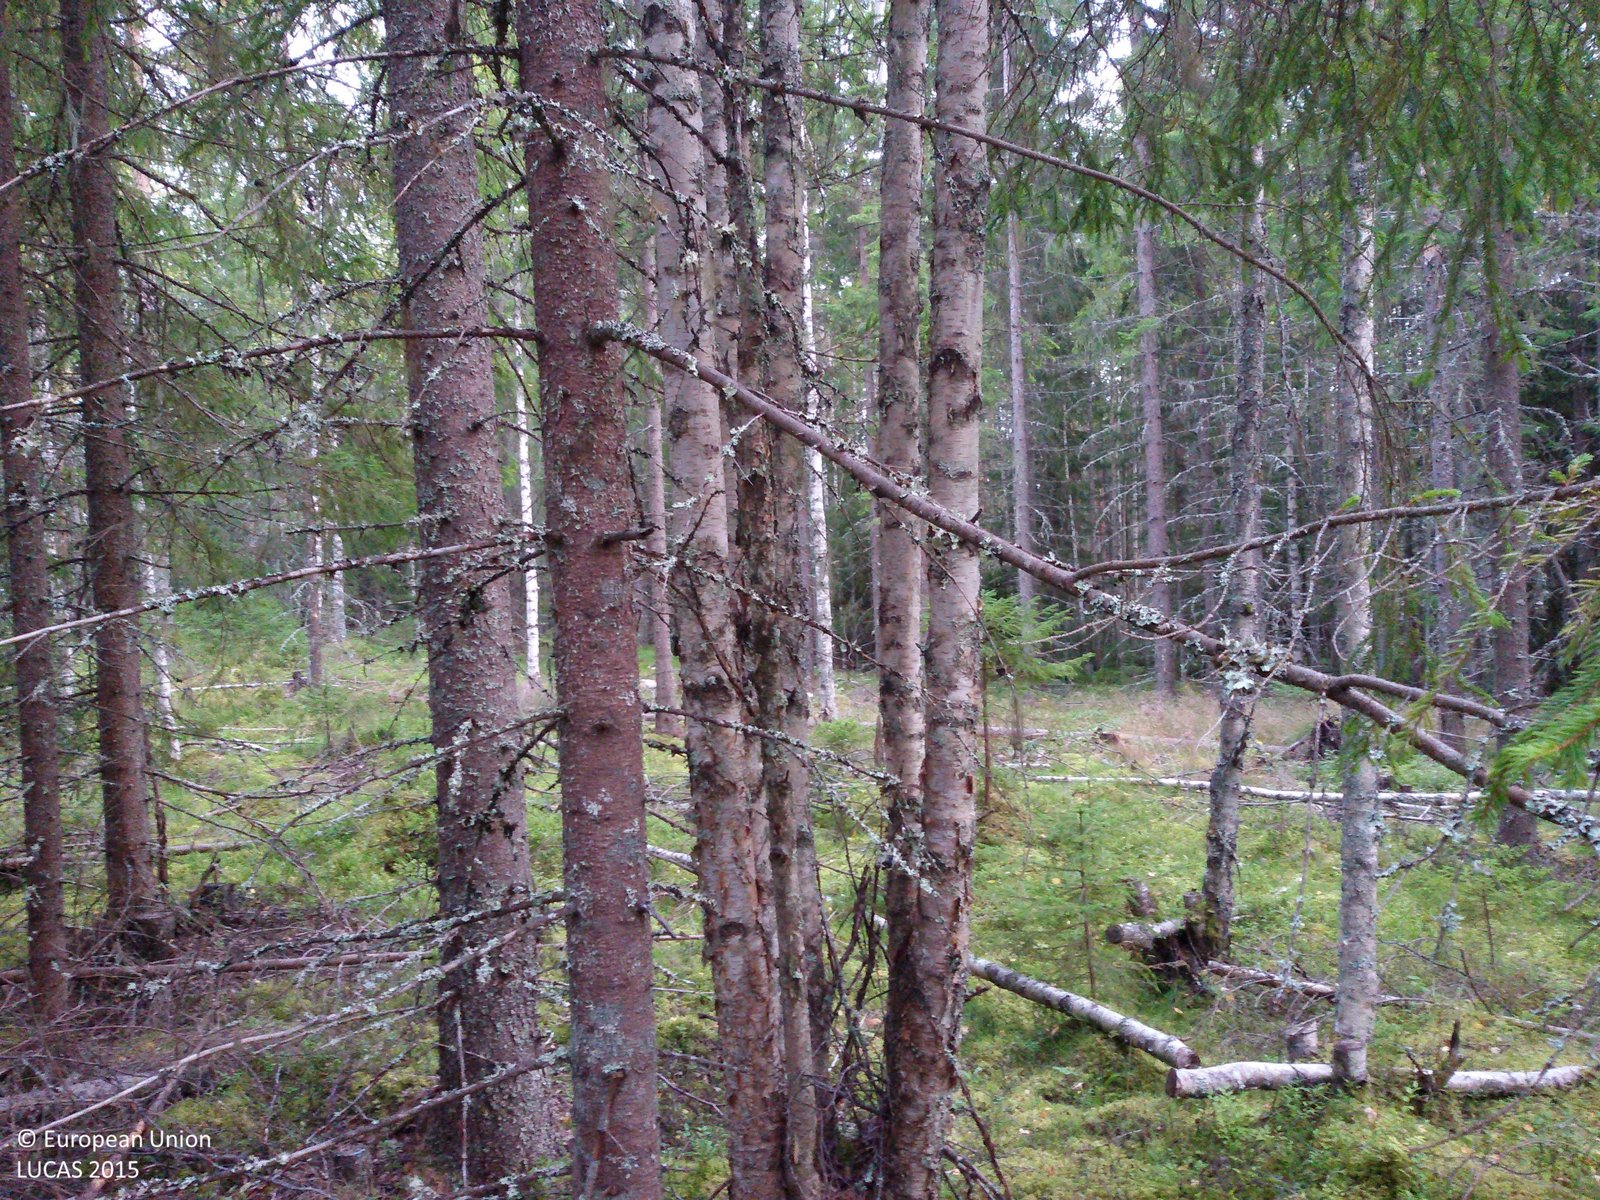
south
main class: Woodland
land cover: Spruce dominated mixed woodland
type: boreal forest
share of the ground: 50 - 75 %
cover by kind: coniferous forest trees 60 %, broadleaved forest trees 20 %, herbaceous plants 10 %, lichens and mosses 10 %
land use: Forestry
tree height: > 5 m
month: September
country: SE
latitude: 60.9919
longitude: 15.0698
